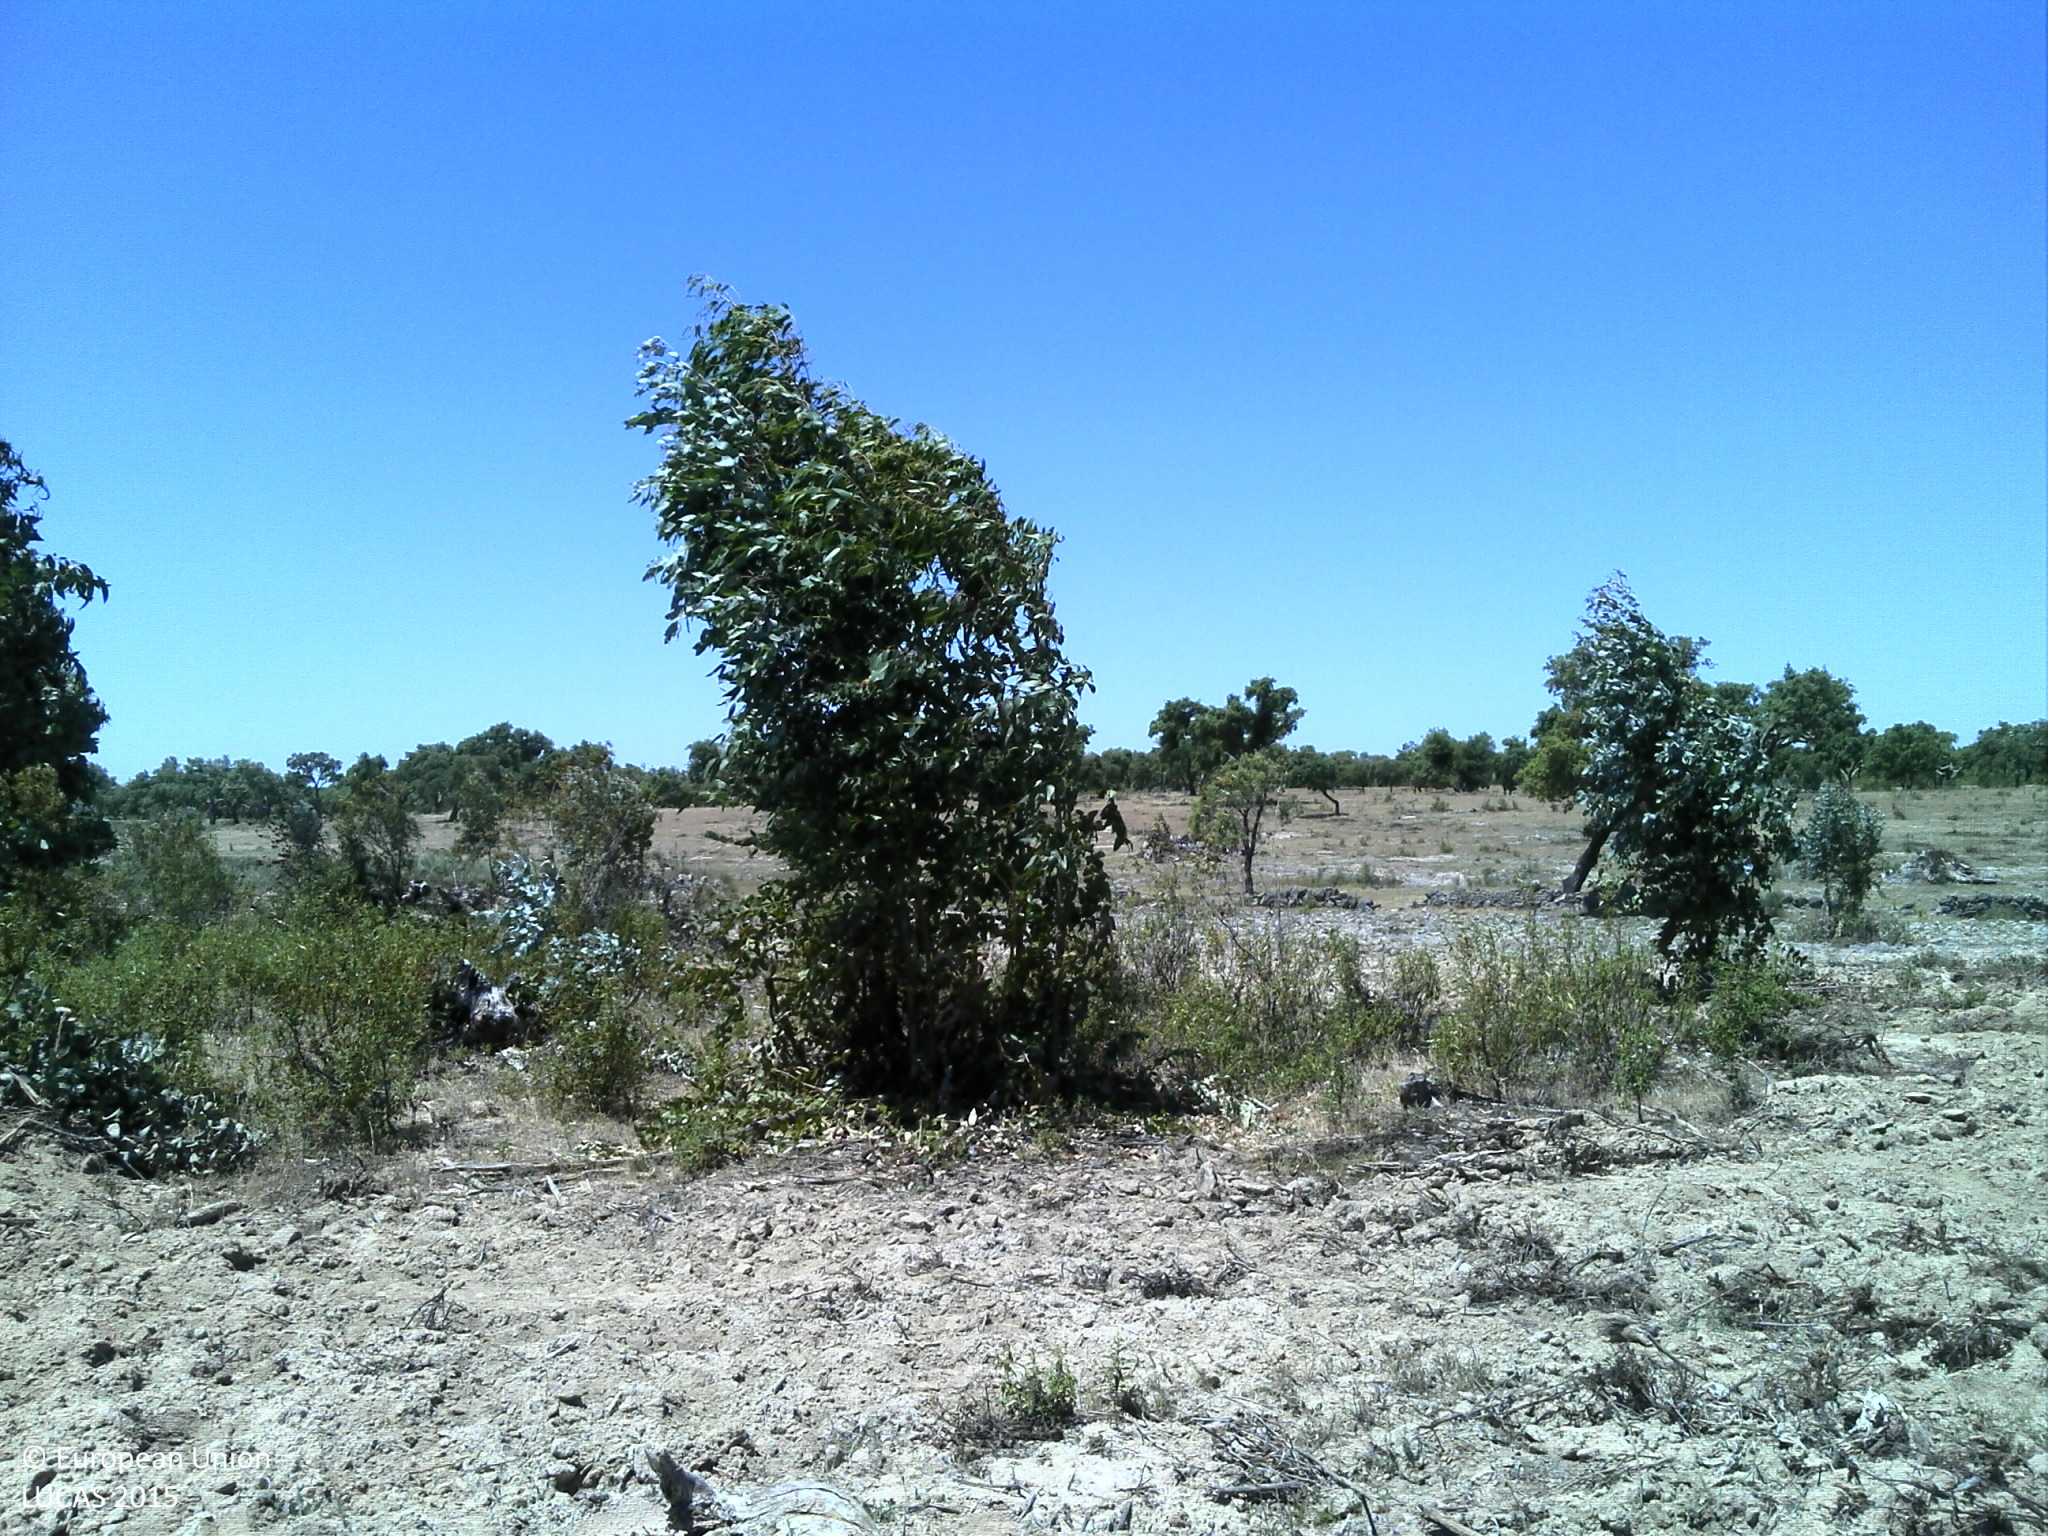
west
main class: Woodland
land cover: Broadleaved woodland
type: exotic forest
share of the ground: 10 - 25 %
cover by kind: unconsolidated bare surface 90 %, broadleaved forest trees 10 %
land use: Forestry
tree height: > 5 m
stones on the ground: < 10 %
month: May
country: PT
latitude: 39.4554
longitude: -7.7041
